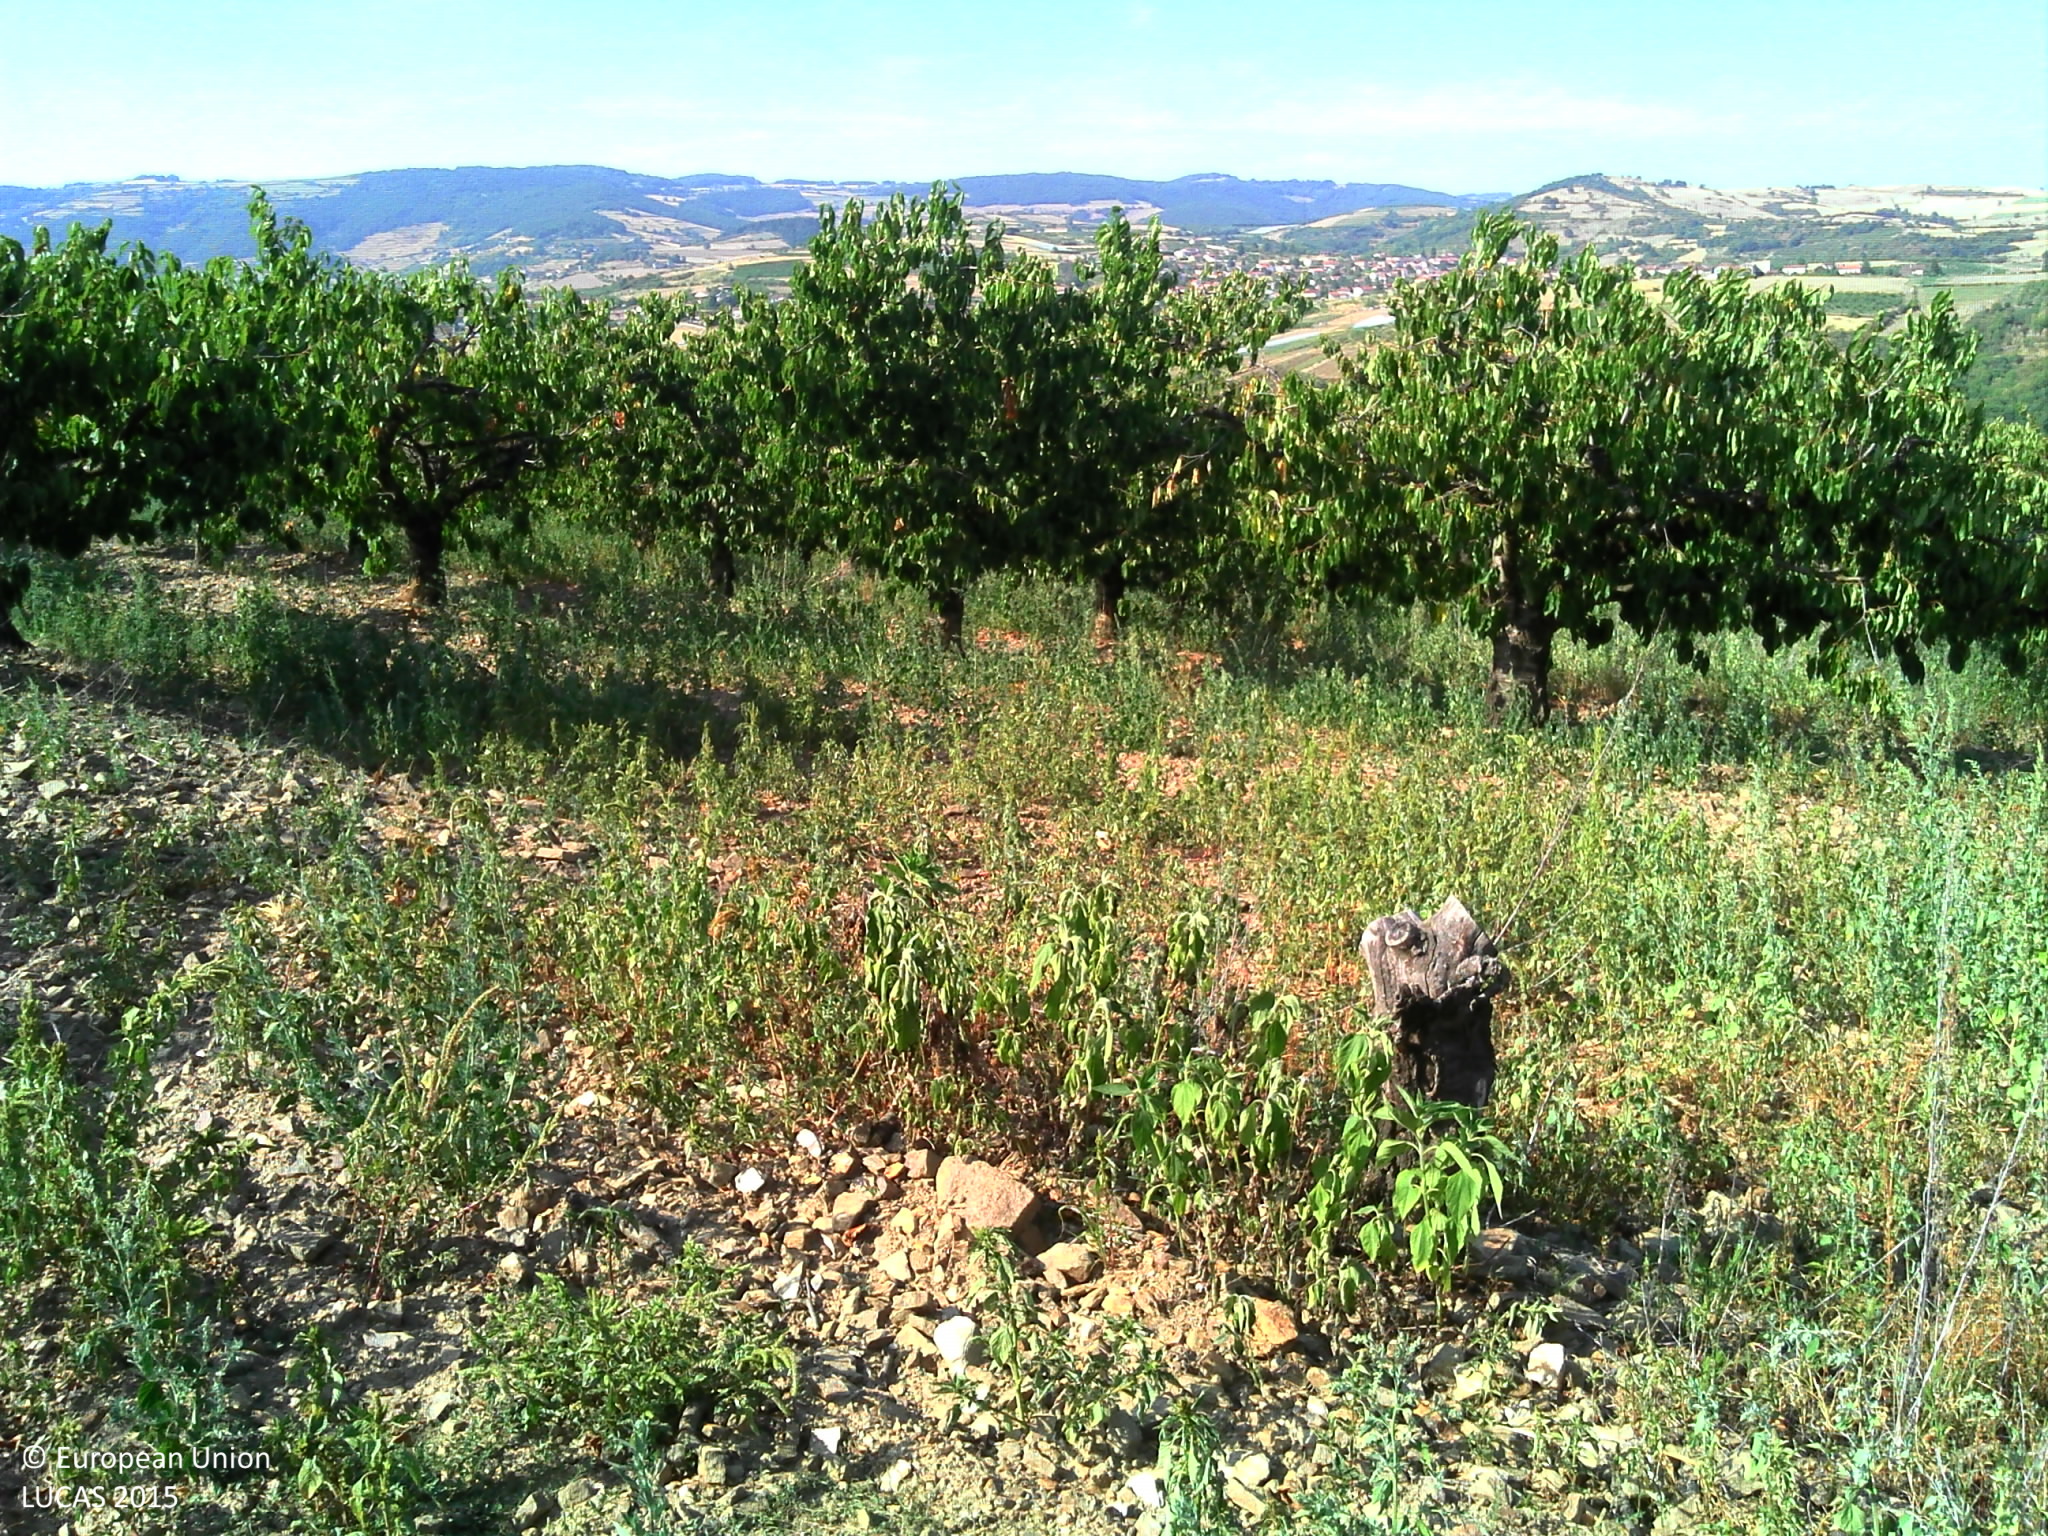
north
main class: Cropland
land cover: Cherry fruit
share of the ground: 25 - 50 %
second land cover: Spontaneously vegetated surfaces
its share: > 75 %
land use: Agriculture (excluding fallow land and kitchen gardens)
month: August
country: FR
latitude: 45.5268
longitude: 4.5622
